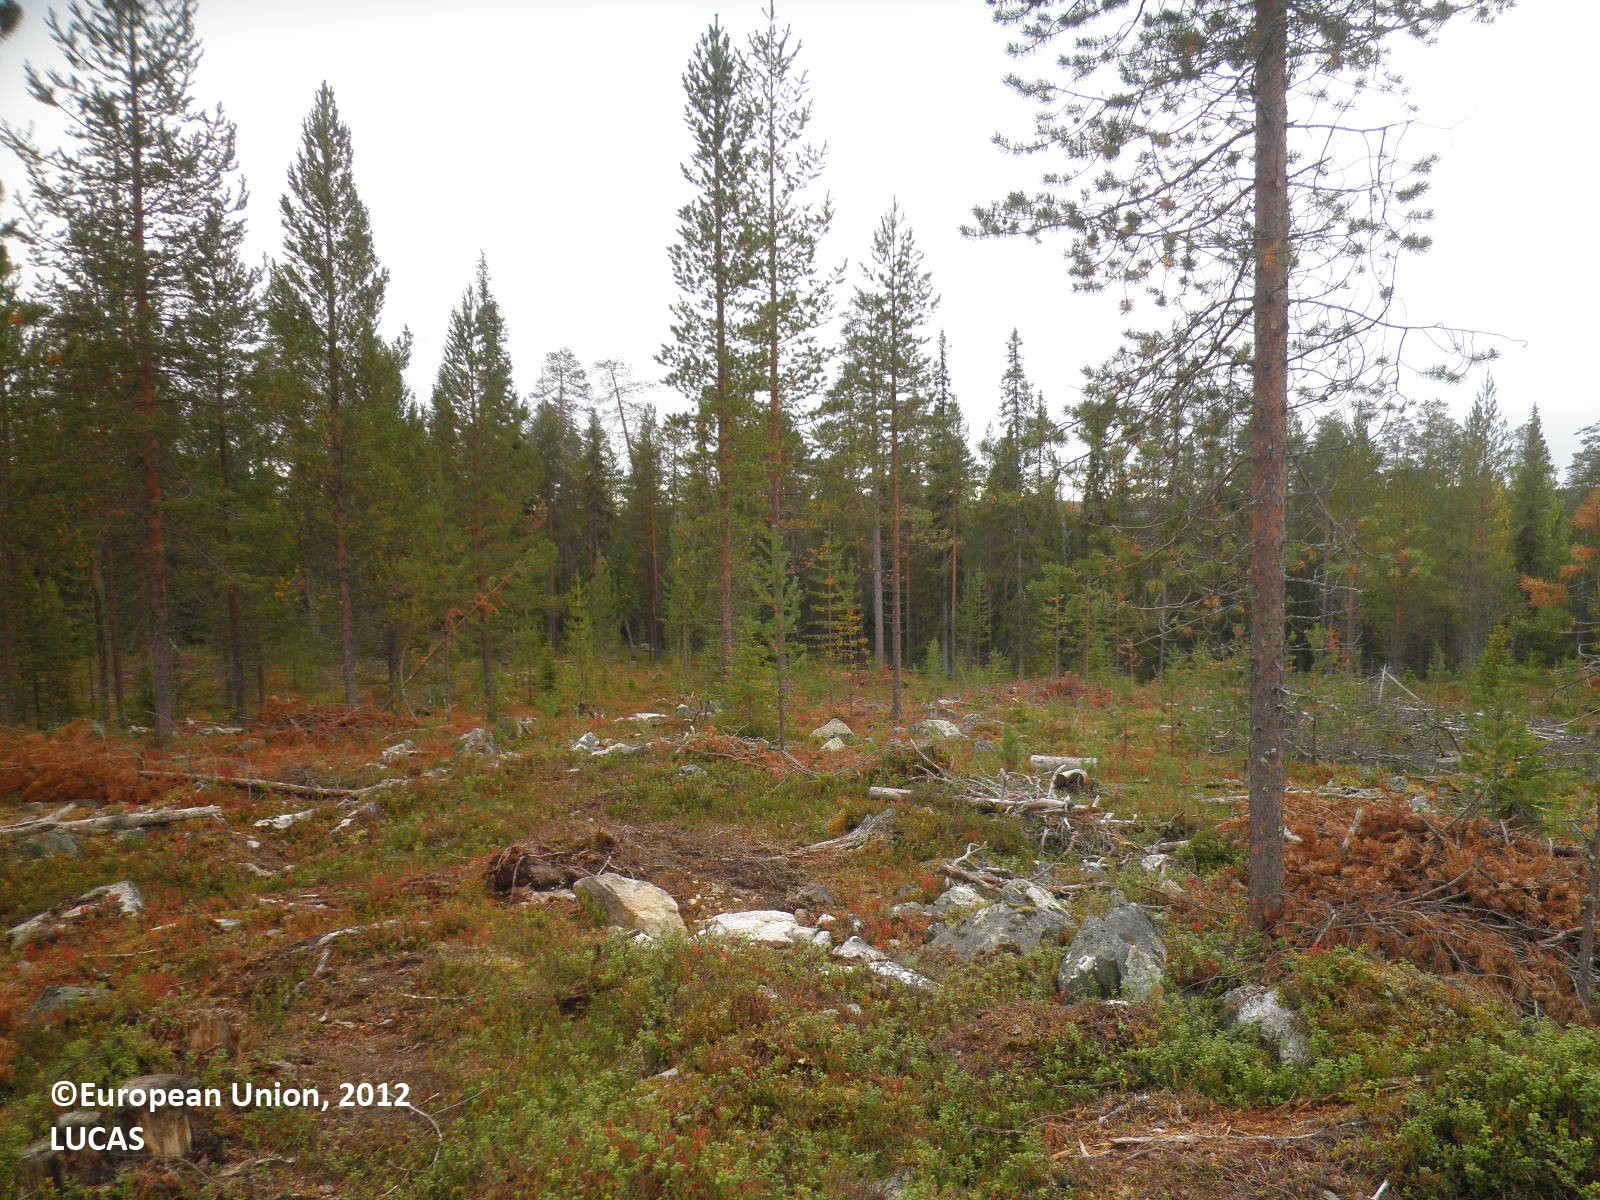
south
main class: Woodland
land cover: Pine dominated coniferous woodland
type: boreal forest
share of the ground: 10 - 25 %
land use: Forestry
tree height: > 5 m
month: September
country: FI
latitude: 67.4335
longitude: 28.6522
